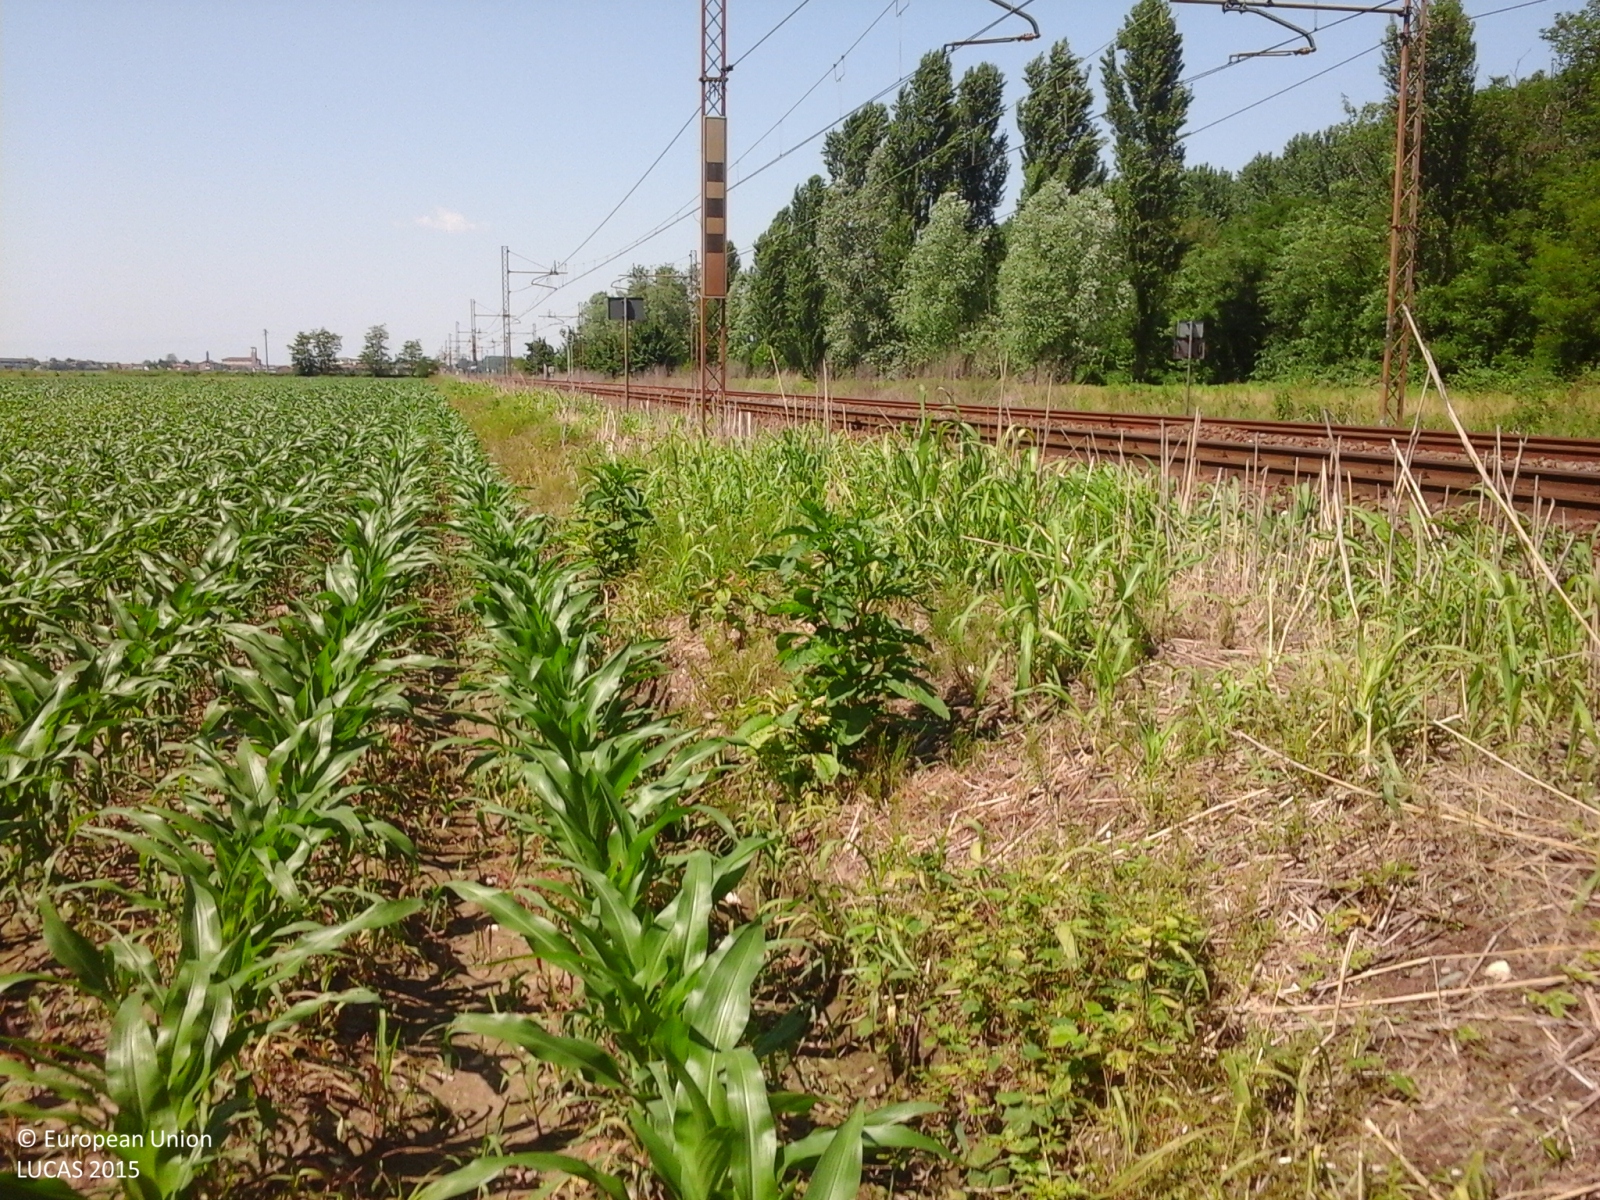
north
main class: Cropland
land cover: Maize
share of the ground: 50 - 75 %
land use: Agriculture (excluding fallow land and kitchen gardens)
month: May
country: IT
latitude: 45.2983
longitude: 8.7143
